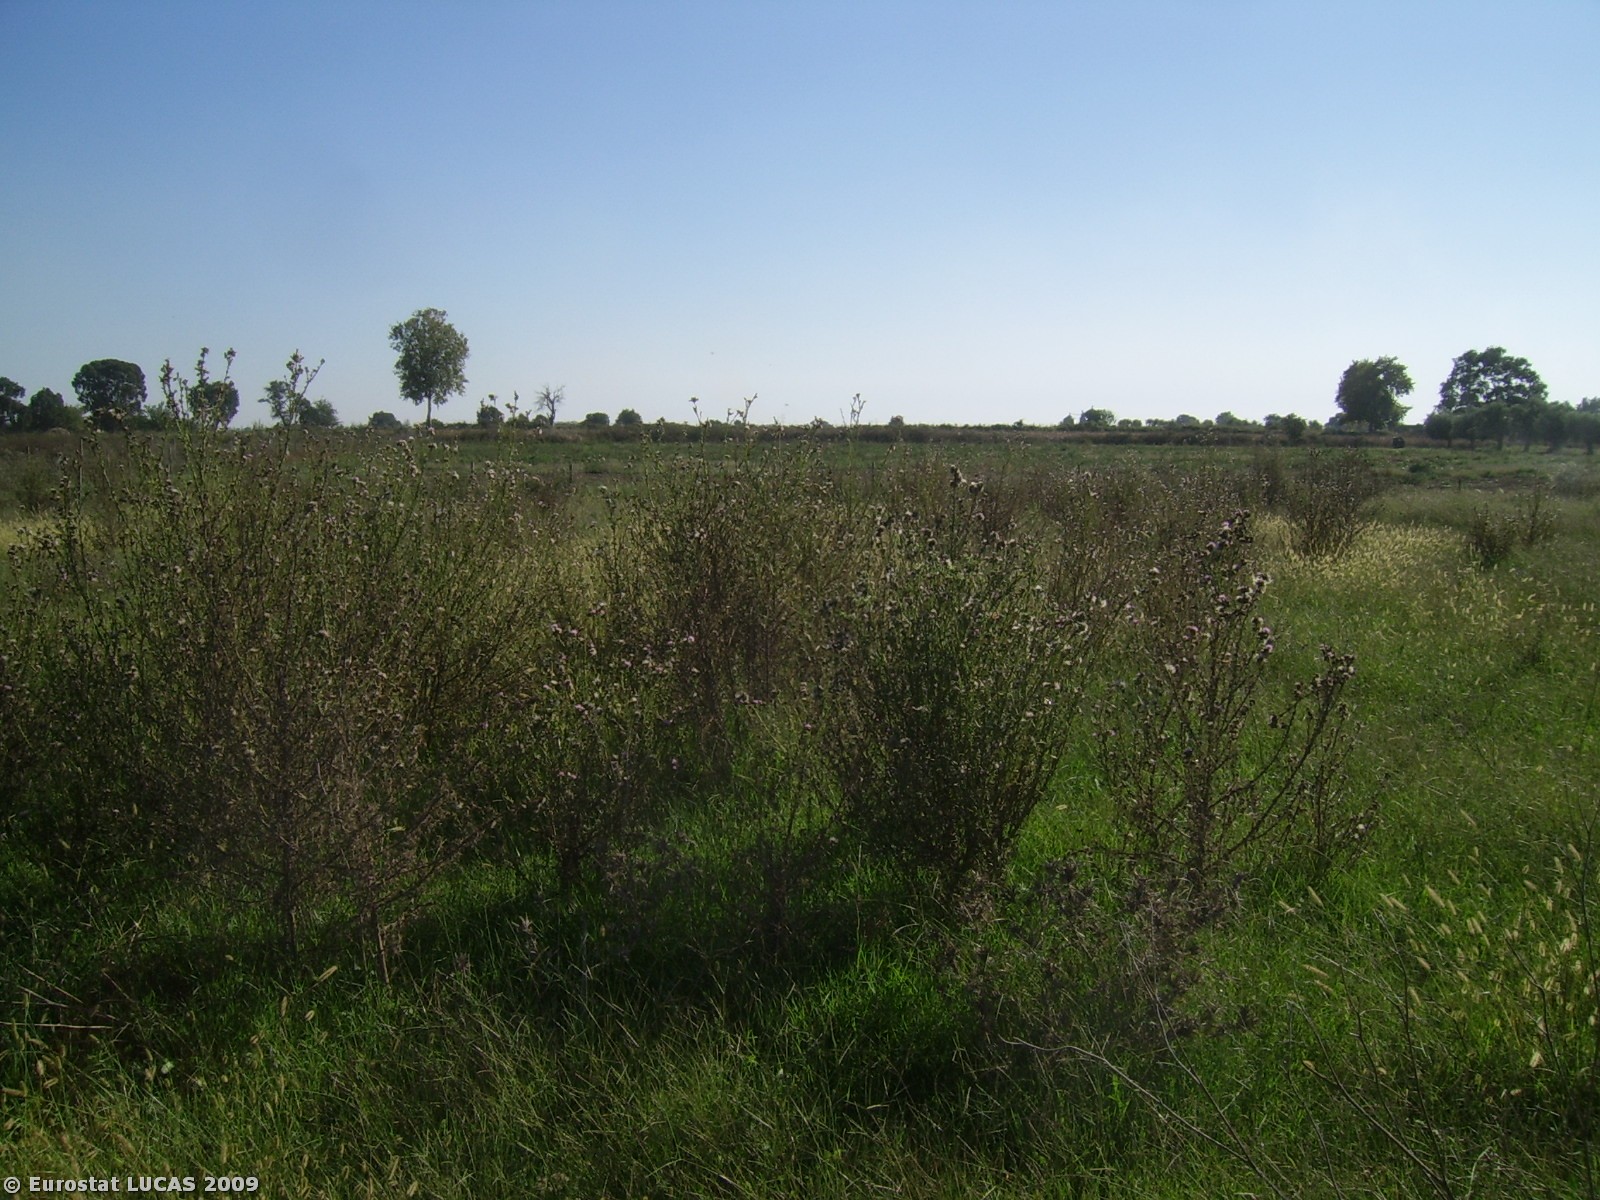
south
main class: Grassland
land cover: Grassland with sparse tree/shrub cover
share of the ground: > 75 %
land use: Unused
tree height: < 5 m
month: October
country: GR
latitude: 37.8565
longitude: 21.3148
